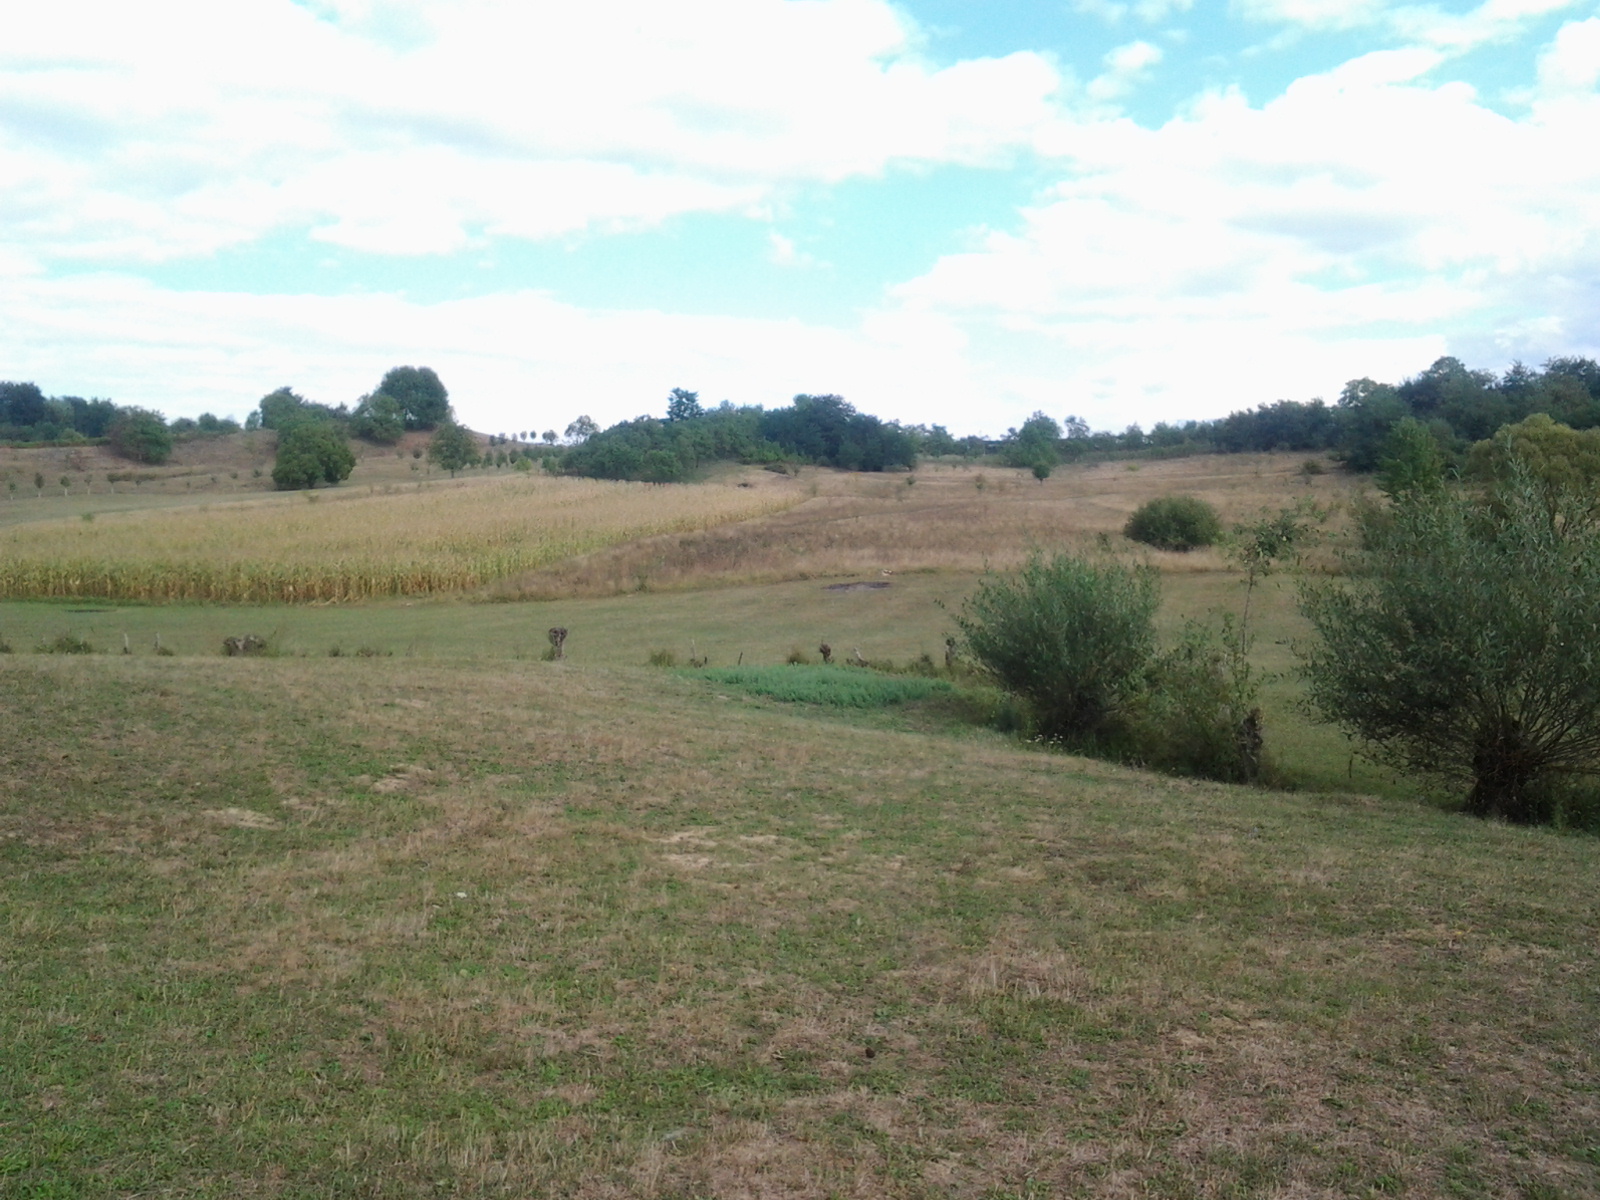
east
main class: Grassland
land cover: Grassland without tree/shrub cover
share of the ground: > 75 %
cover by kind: herbaceous plants 100 %
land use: Agriculture (excluding fallow land and kitchen gardens)
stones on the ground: < 10 %
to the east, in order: Grassland without tree/shrub cover; Abandoned hedges; Rivers and streams; Grassland without tree/shrub cover; Spontaneously vegetated surfaces; Tracks; Spontaneously vegetated surfaces; Maize; Spontaneously vegetated surfaces
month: September
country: RO
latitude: 47.9340
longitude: 23.3657
